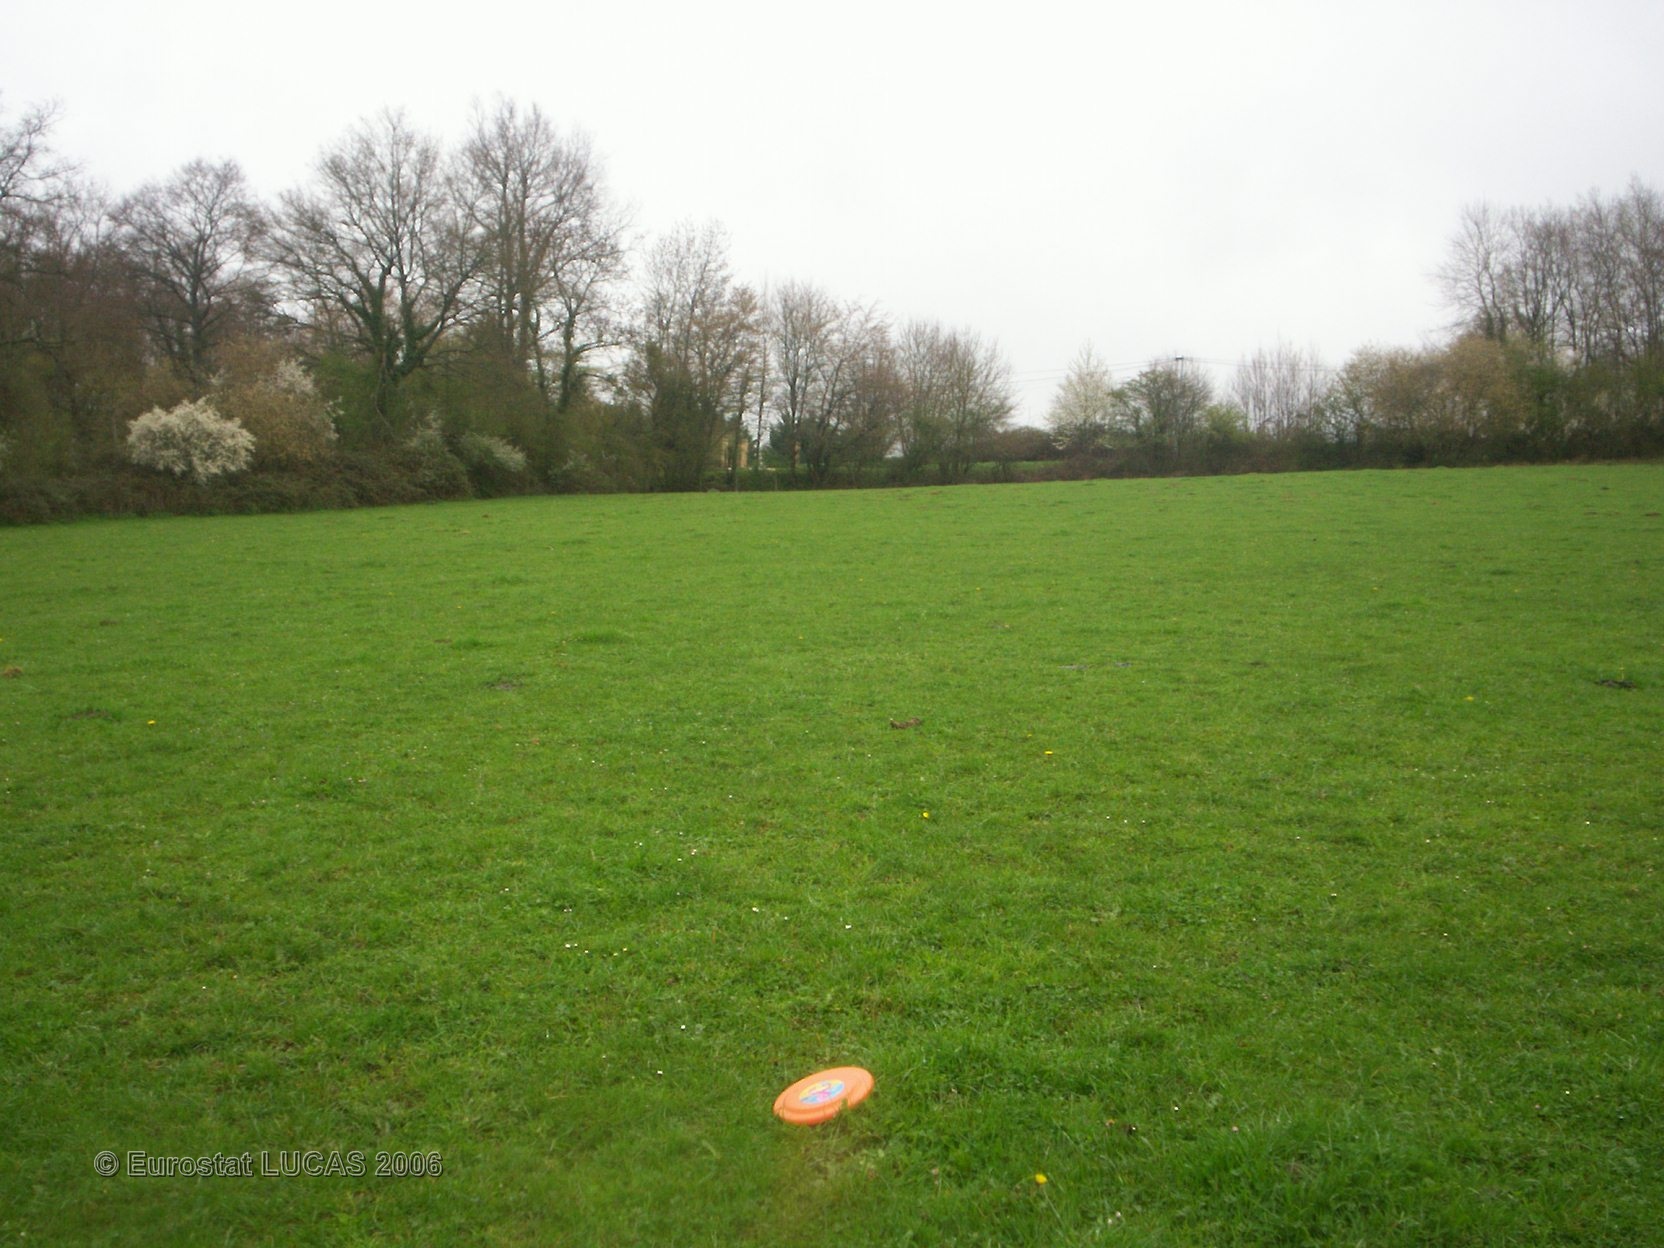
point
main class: Grassland
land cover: Grassland without tree/shrub cover
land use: Agriculture (excluding fallow land and kitchen gardens)
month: April
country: FR
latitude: 47.5309
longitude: 2.9940
